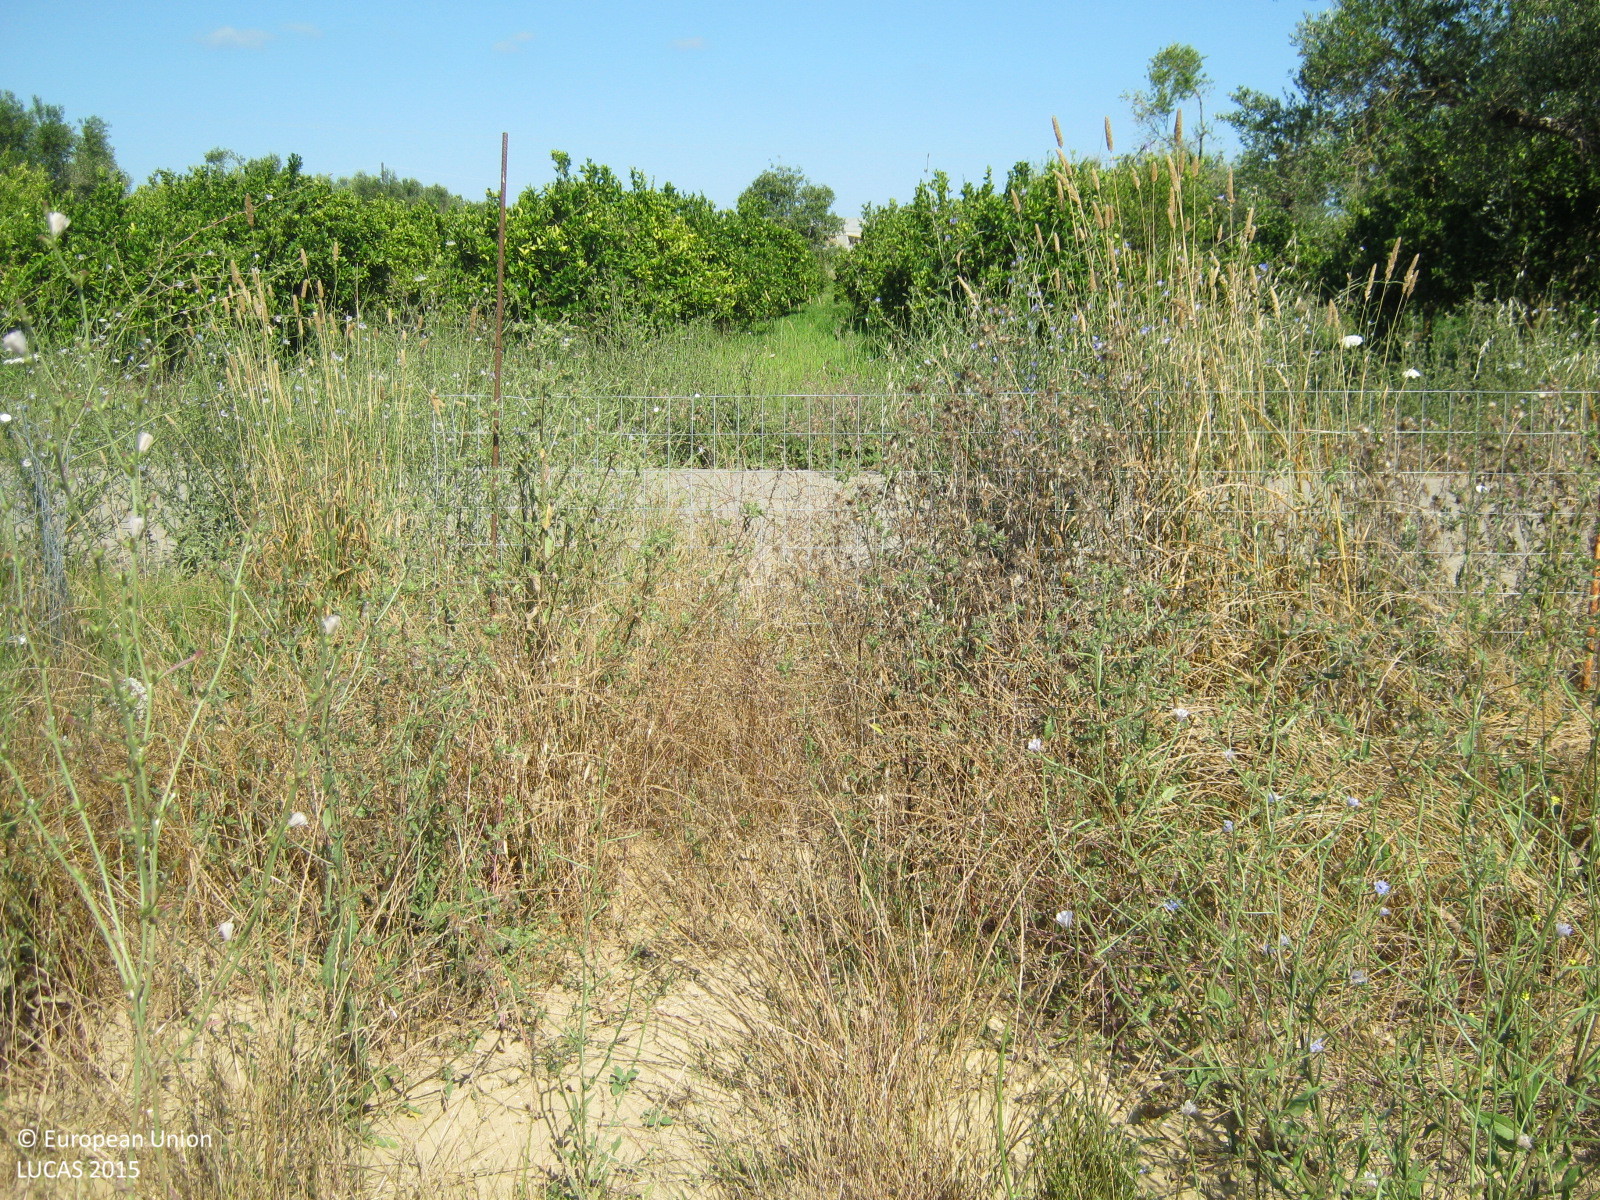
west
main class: Cropland
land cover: Olive groves
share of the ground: < 10 %
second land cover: Spontaneously vegetated surfaces
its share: > 75 %
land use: Agriculture (excluding fallow land and kitchen gardens)
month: June
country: GR
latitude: 37.8519
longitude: 21.1999
